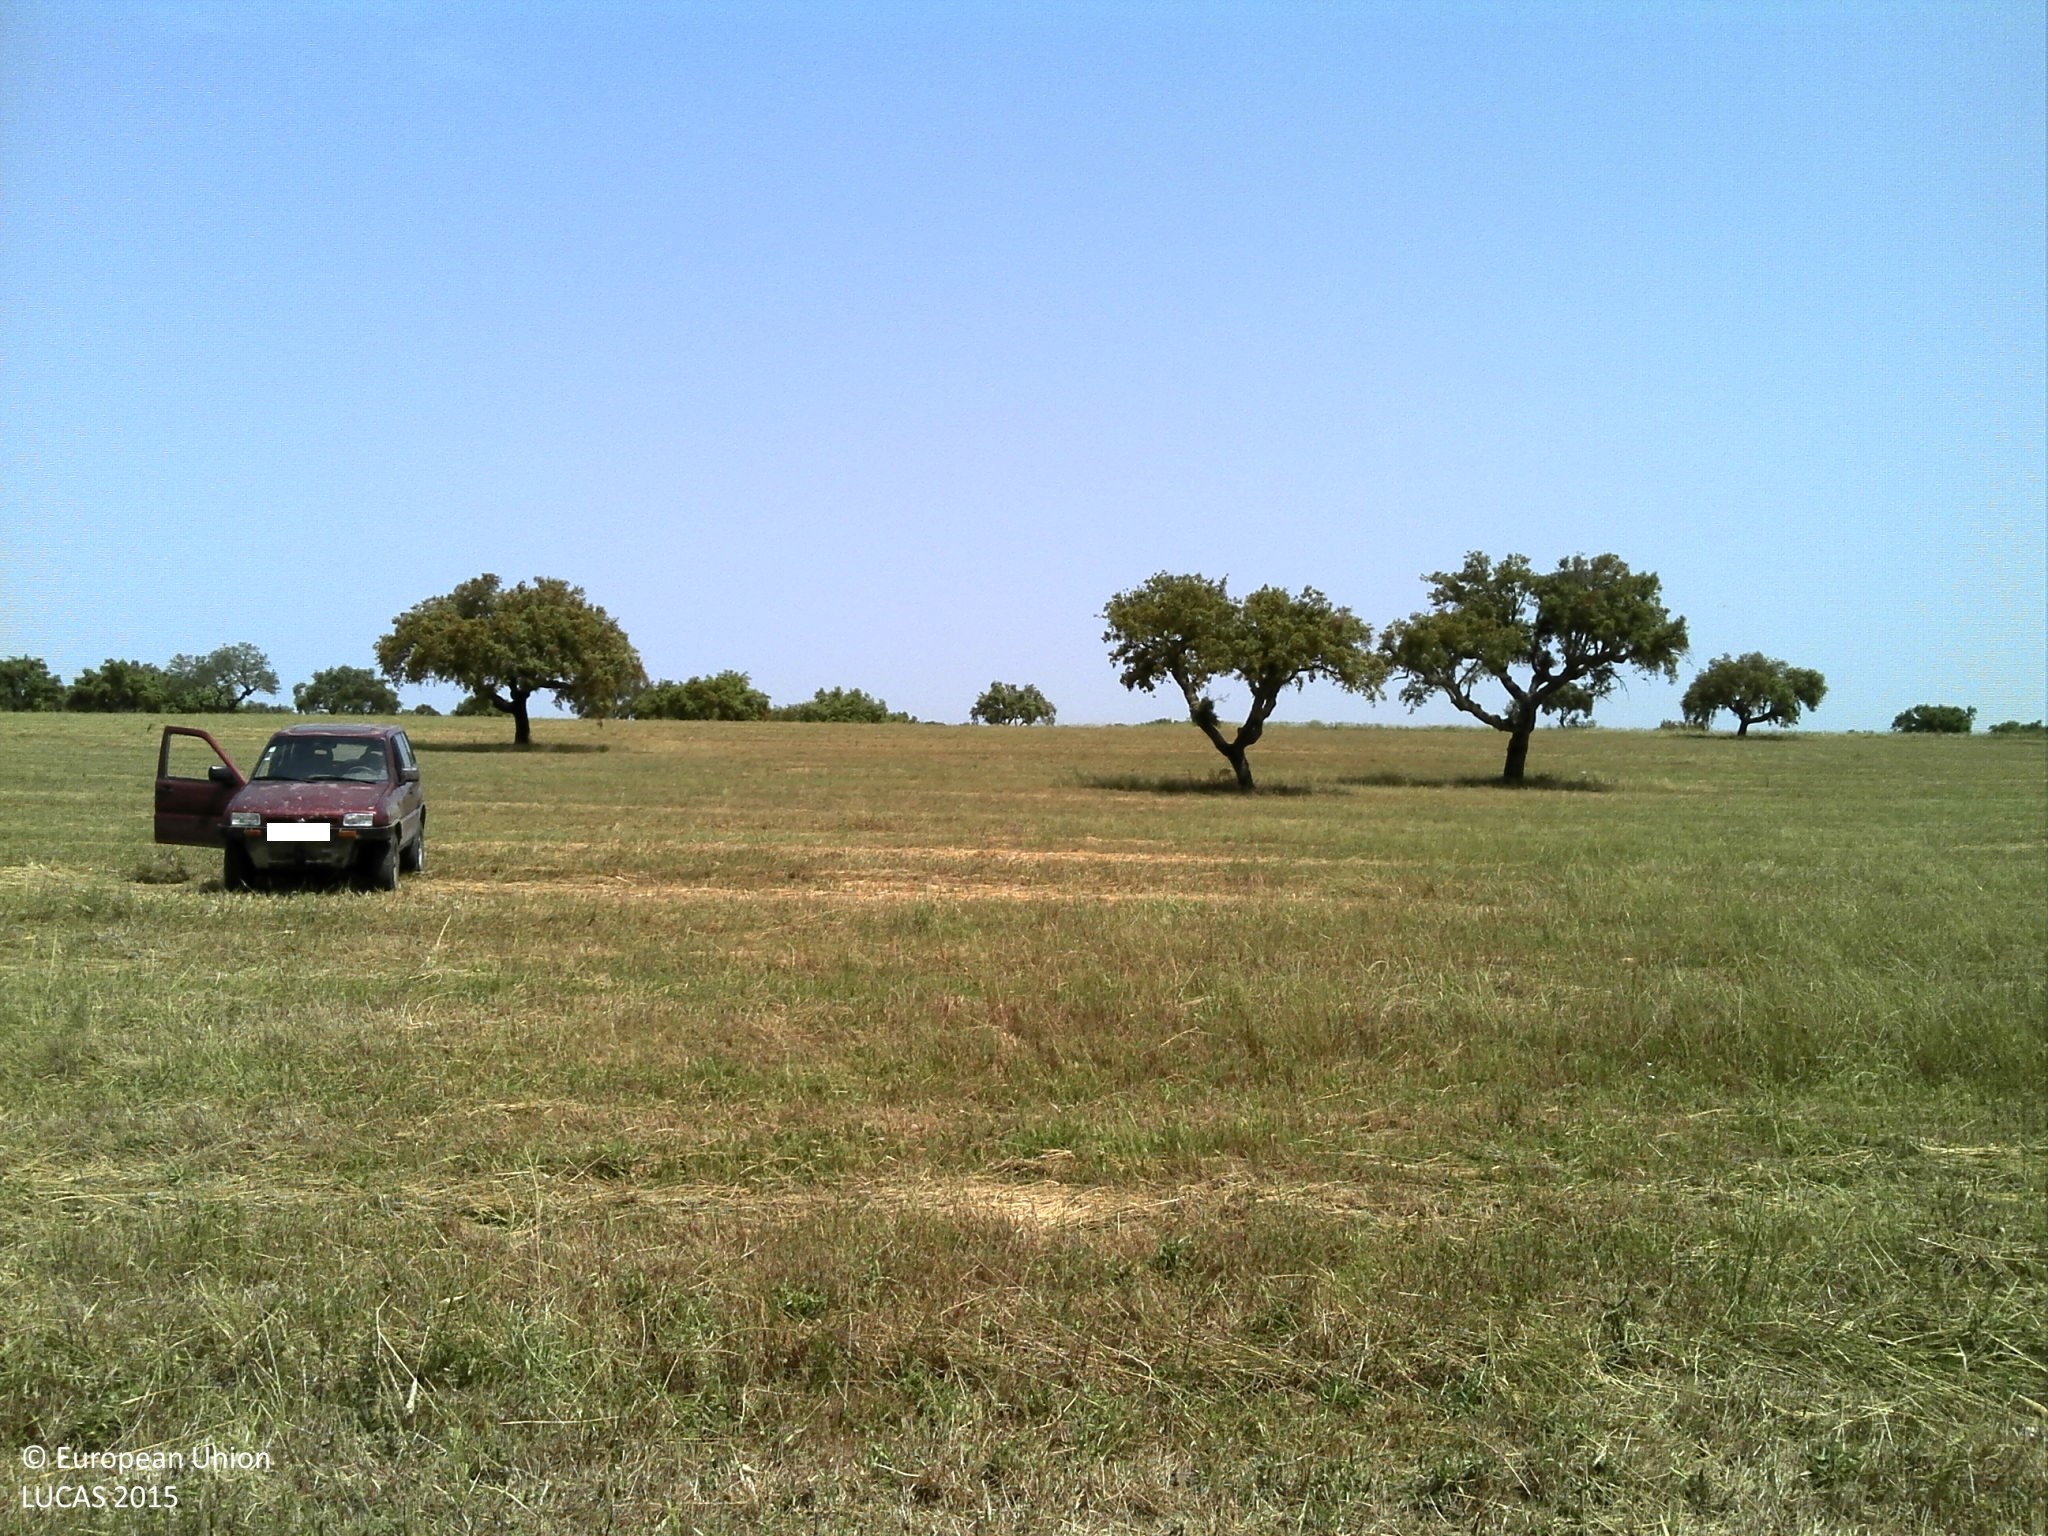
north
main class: Cropland
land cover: Oats
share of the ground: 50 - 75 %
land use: Agriculture (excluding fallow land and kitchen gardens)
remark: Harvested field
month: May
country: PT
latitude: 38.9616
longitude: -7.8761
